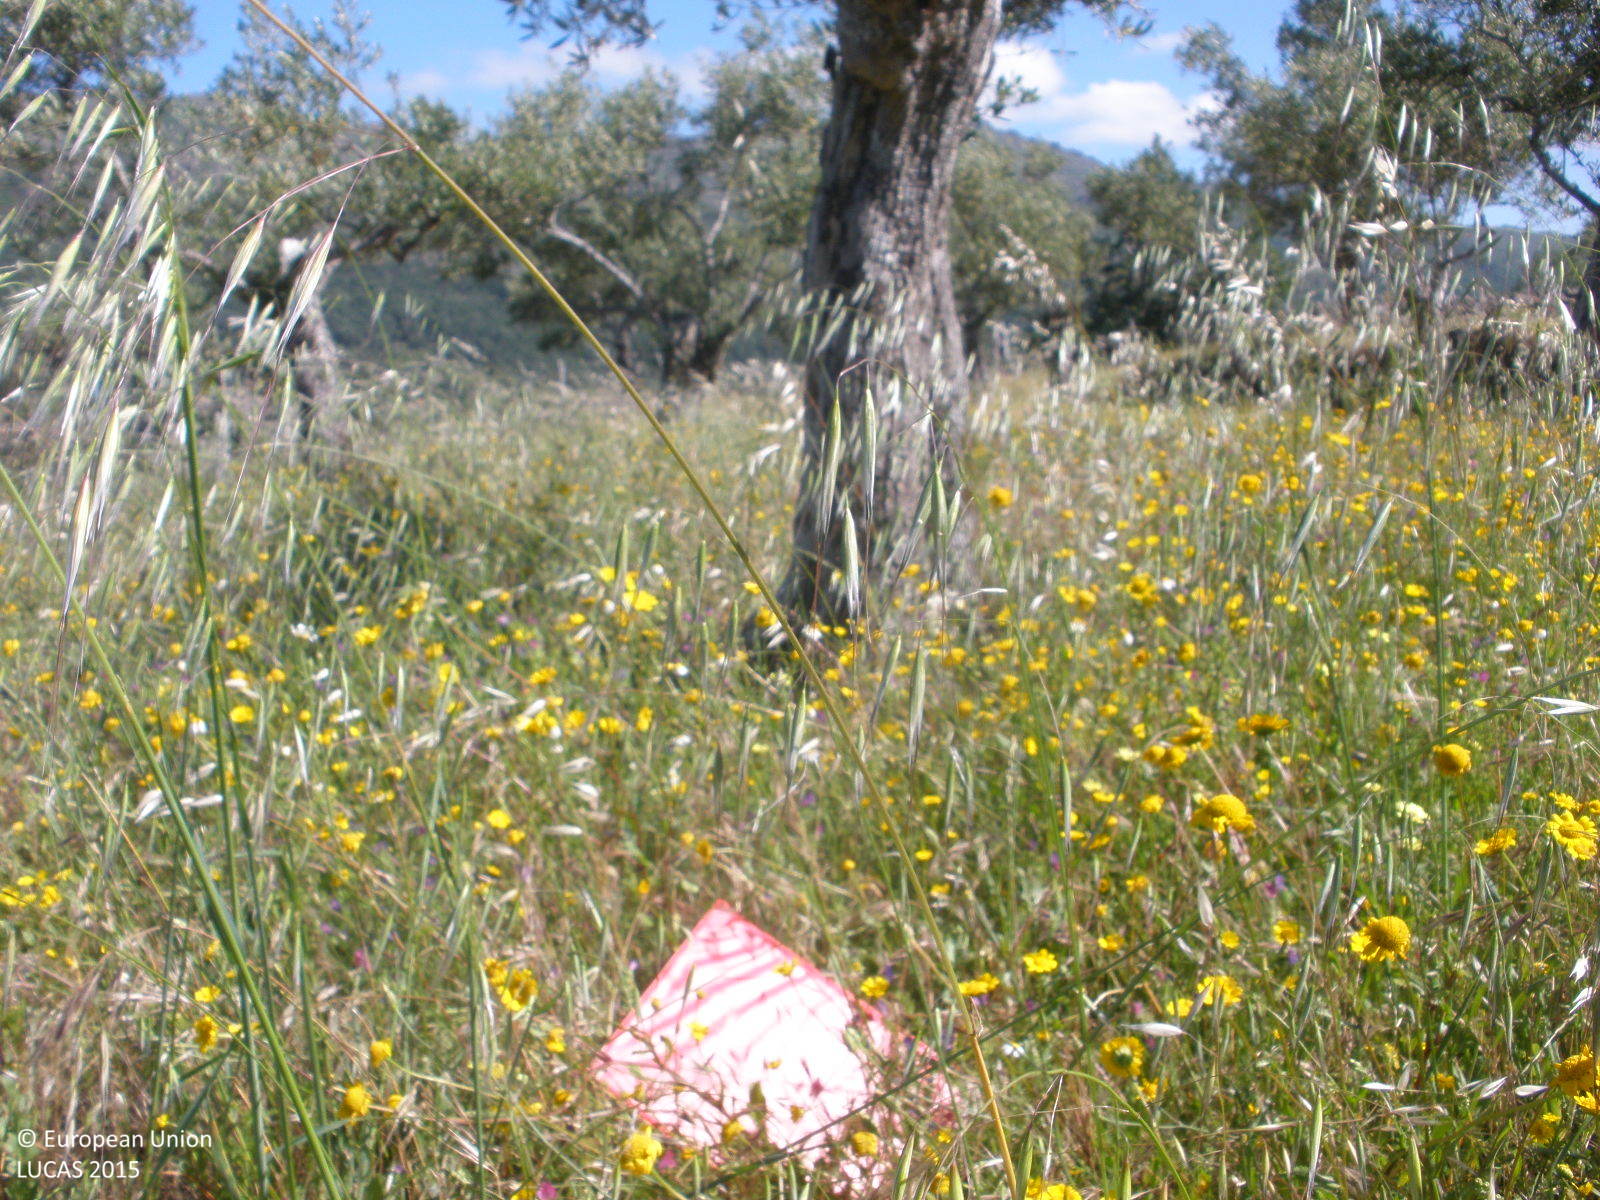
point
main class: Cropland
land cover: Olive groves
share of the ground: 50 - 75 %
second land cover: Spontaneously vegetated surfaces
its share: > 75 %
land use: Agriculture (excluding fallow land and kitchen gardens)
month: May
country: ES
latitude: 40.2062
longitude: -6.8080
